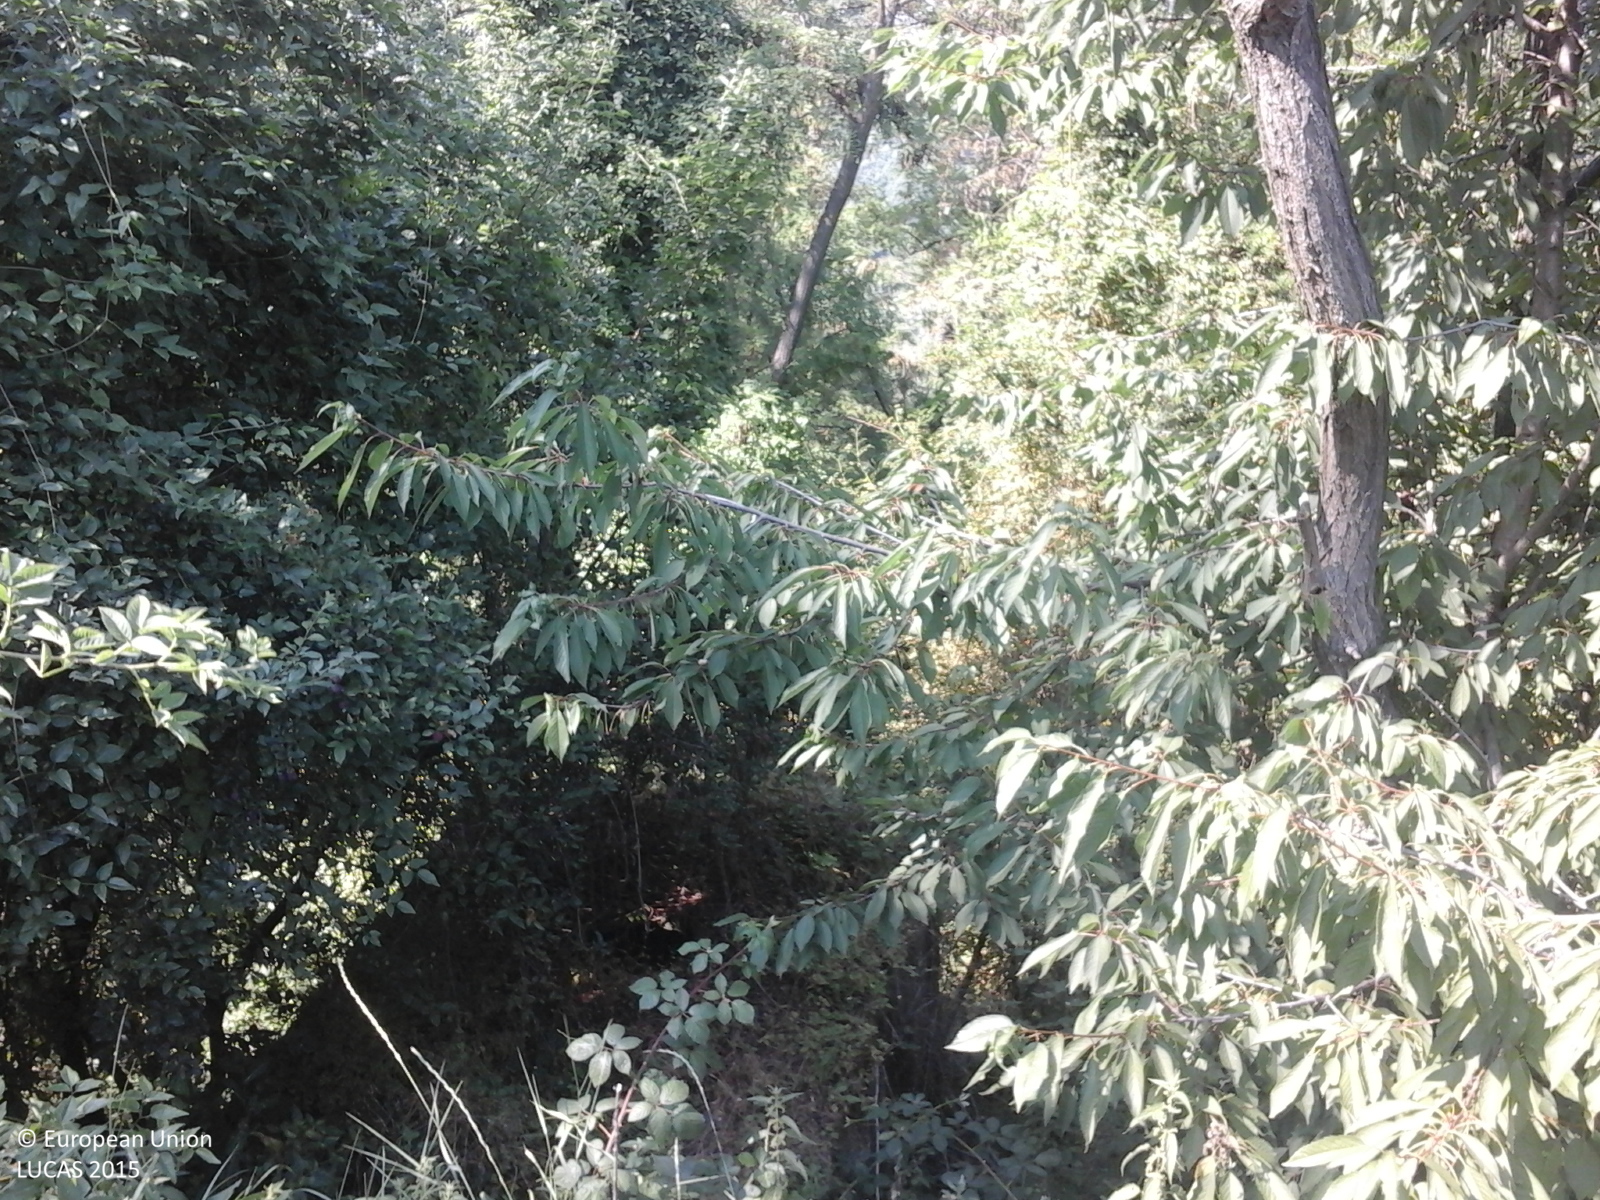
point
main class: Woodland
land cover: Broadleaved woodland
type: broadleaved evergreen forest
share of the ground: > 75 %
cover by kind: broadleaved forest trees 100 %
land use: Forestry
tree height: > 5 m
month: July
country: RO
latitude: 45.0512
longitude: 24.4610
